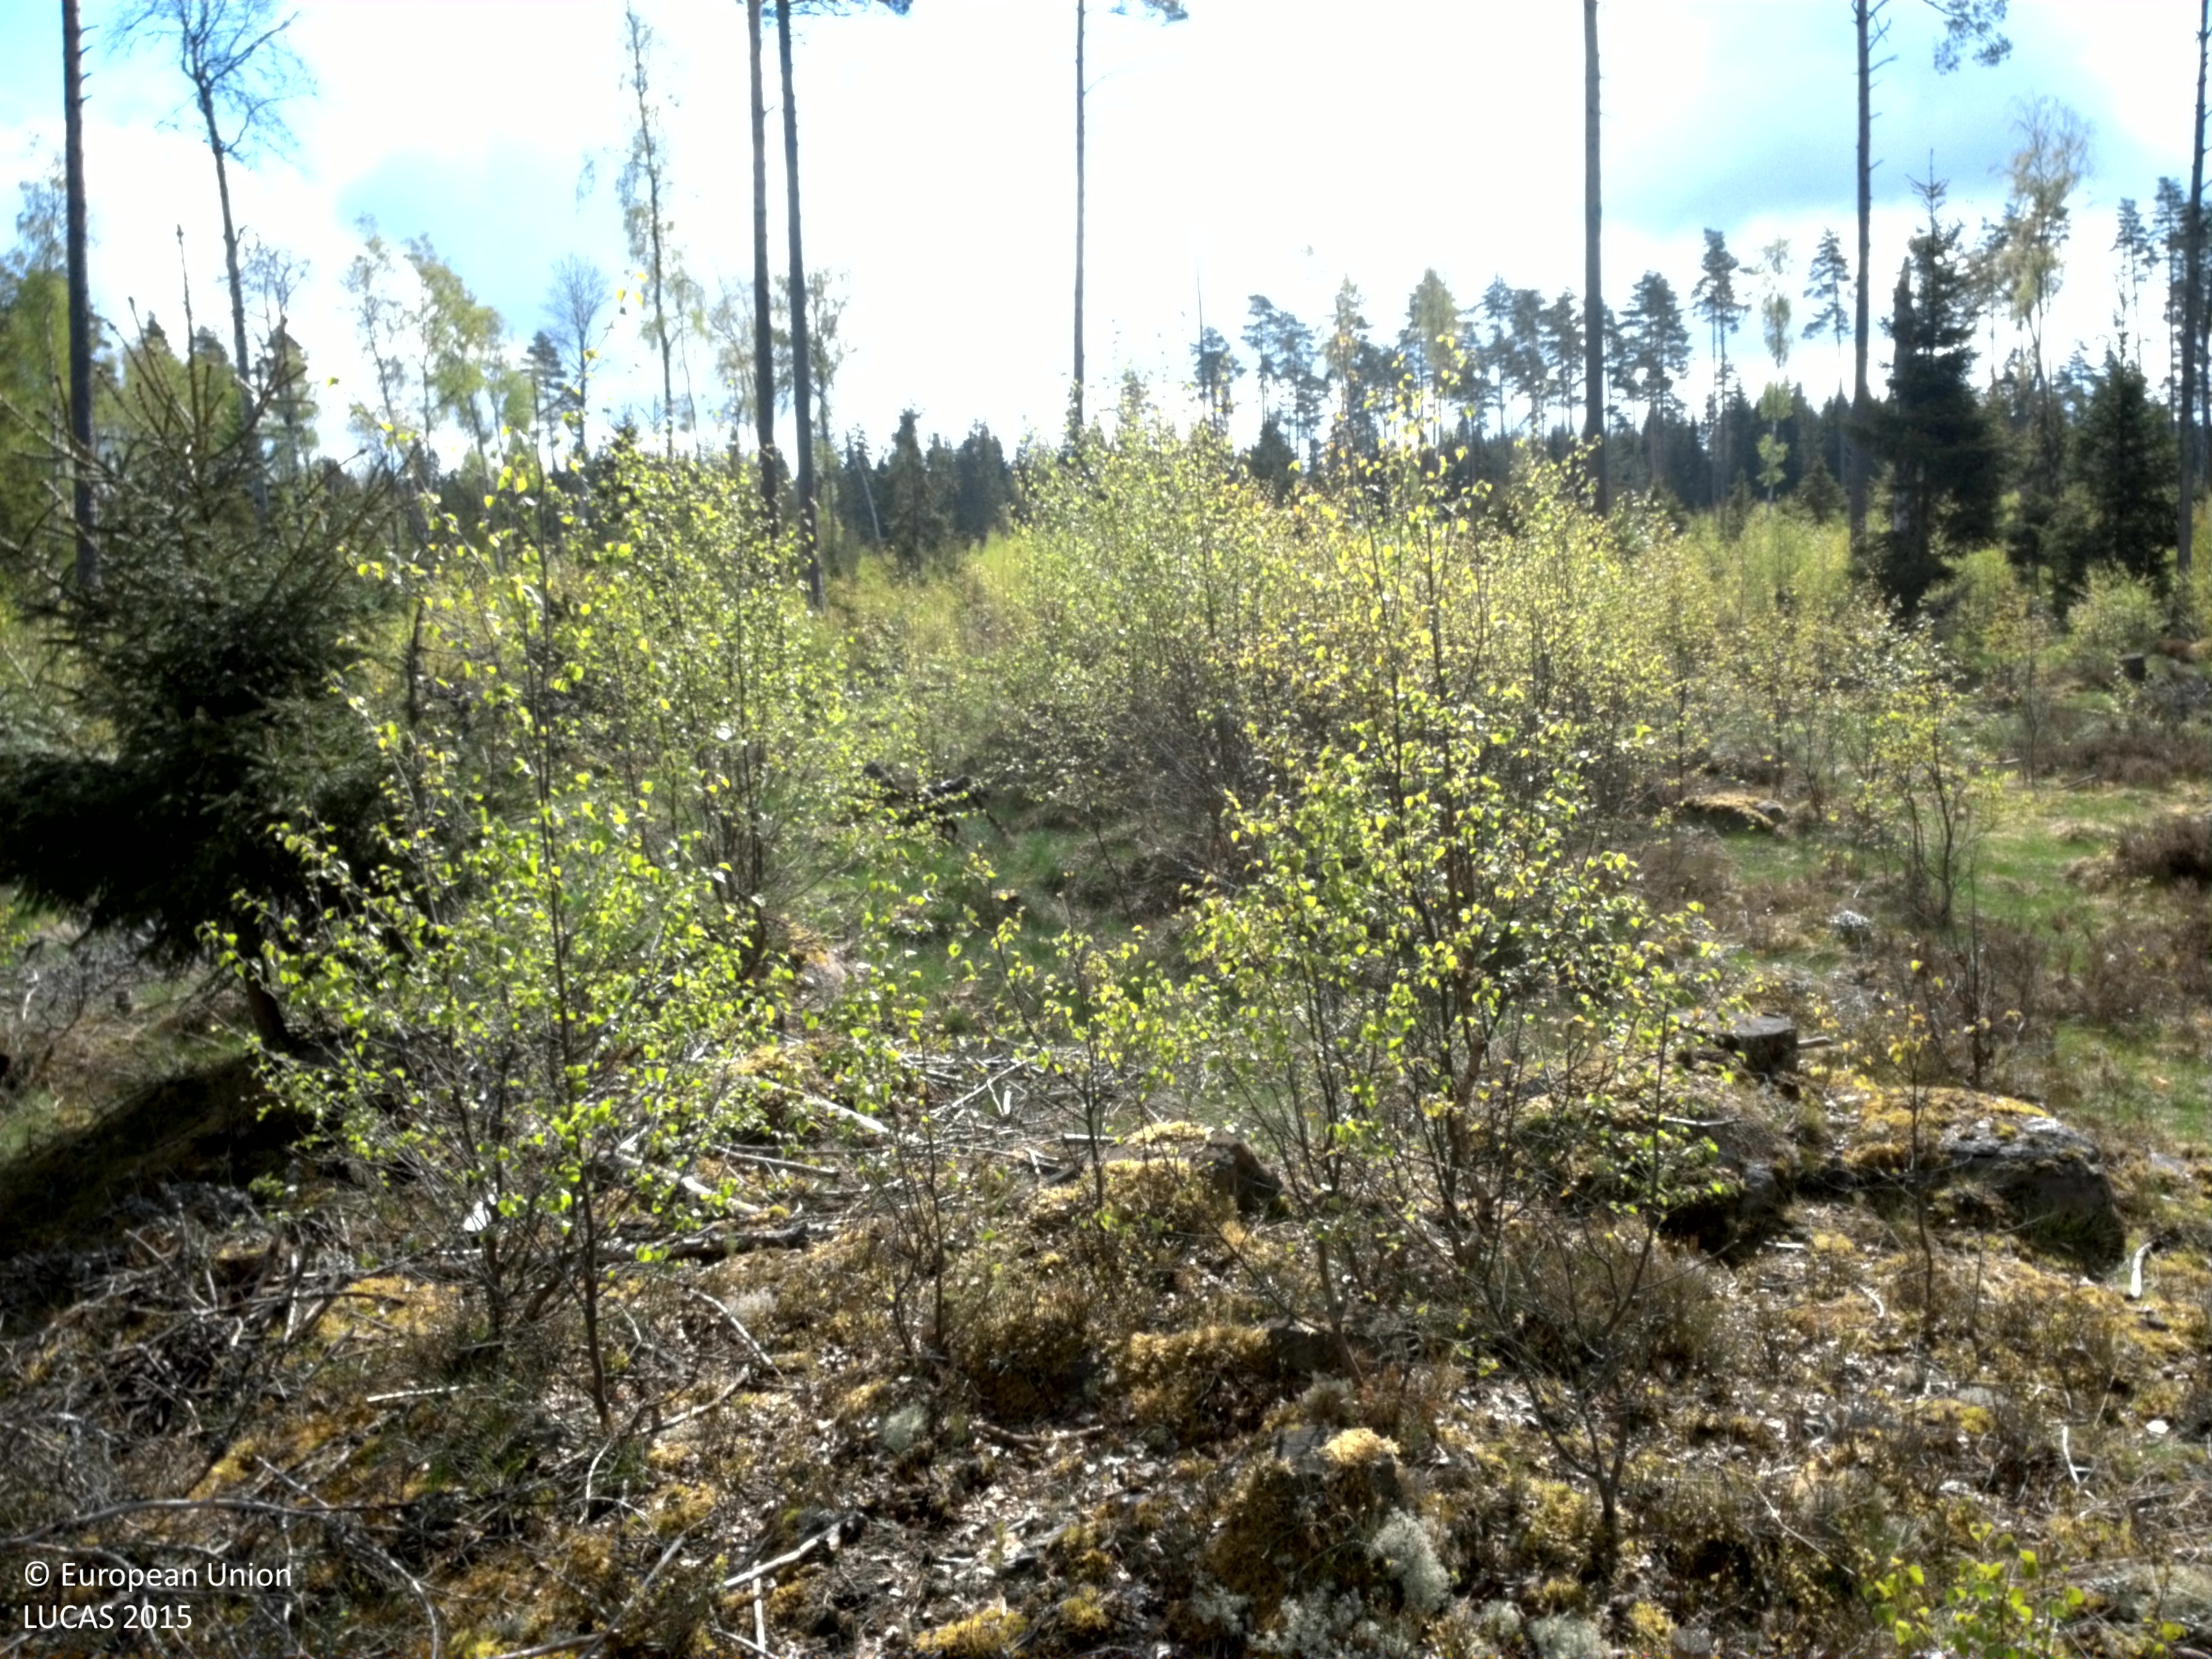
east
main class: Woodland
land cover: Pine dominated coniferous woodland
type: boreal forest
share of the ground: 25 - 50 %
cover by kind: coniferous forest trees 60 %, broadleaved forest trees 20 %, herbaceous plants 10 %, lichens and mosses 10 %
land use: Forestry
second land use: Amenities, museums, leisure
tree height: > 5 m
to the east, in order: Pine dominated coniferous woodland; Broadleaved woodland; Shrubland with sparse tree cover; Grassland without tree/shrub cover
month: May
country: SE
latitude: 56.8984
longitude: 15.0706
